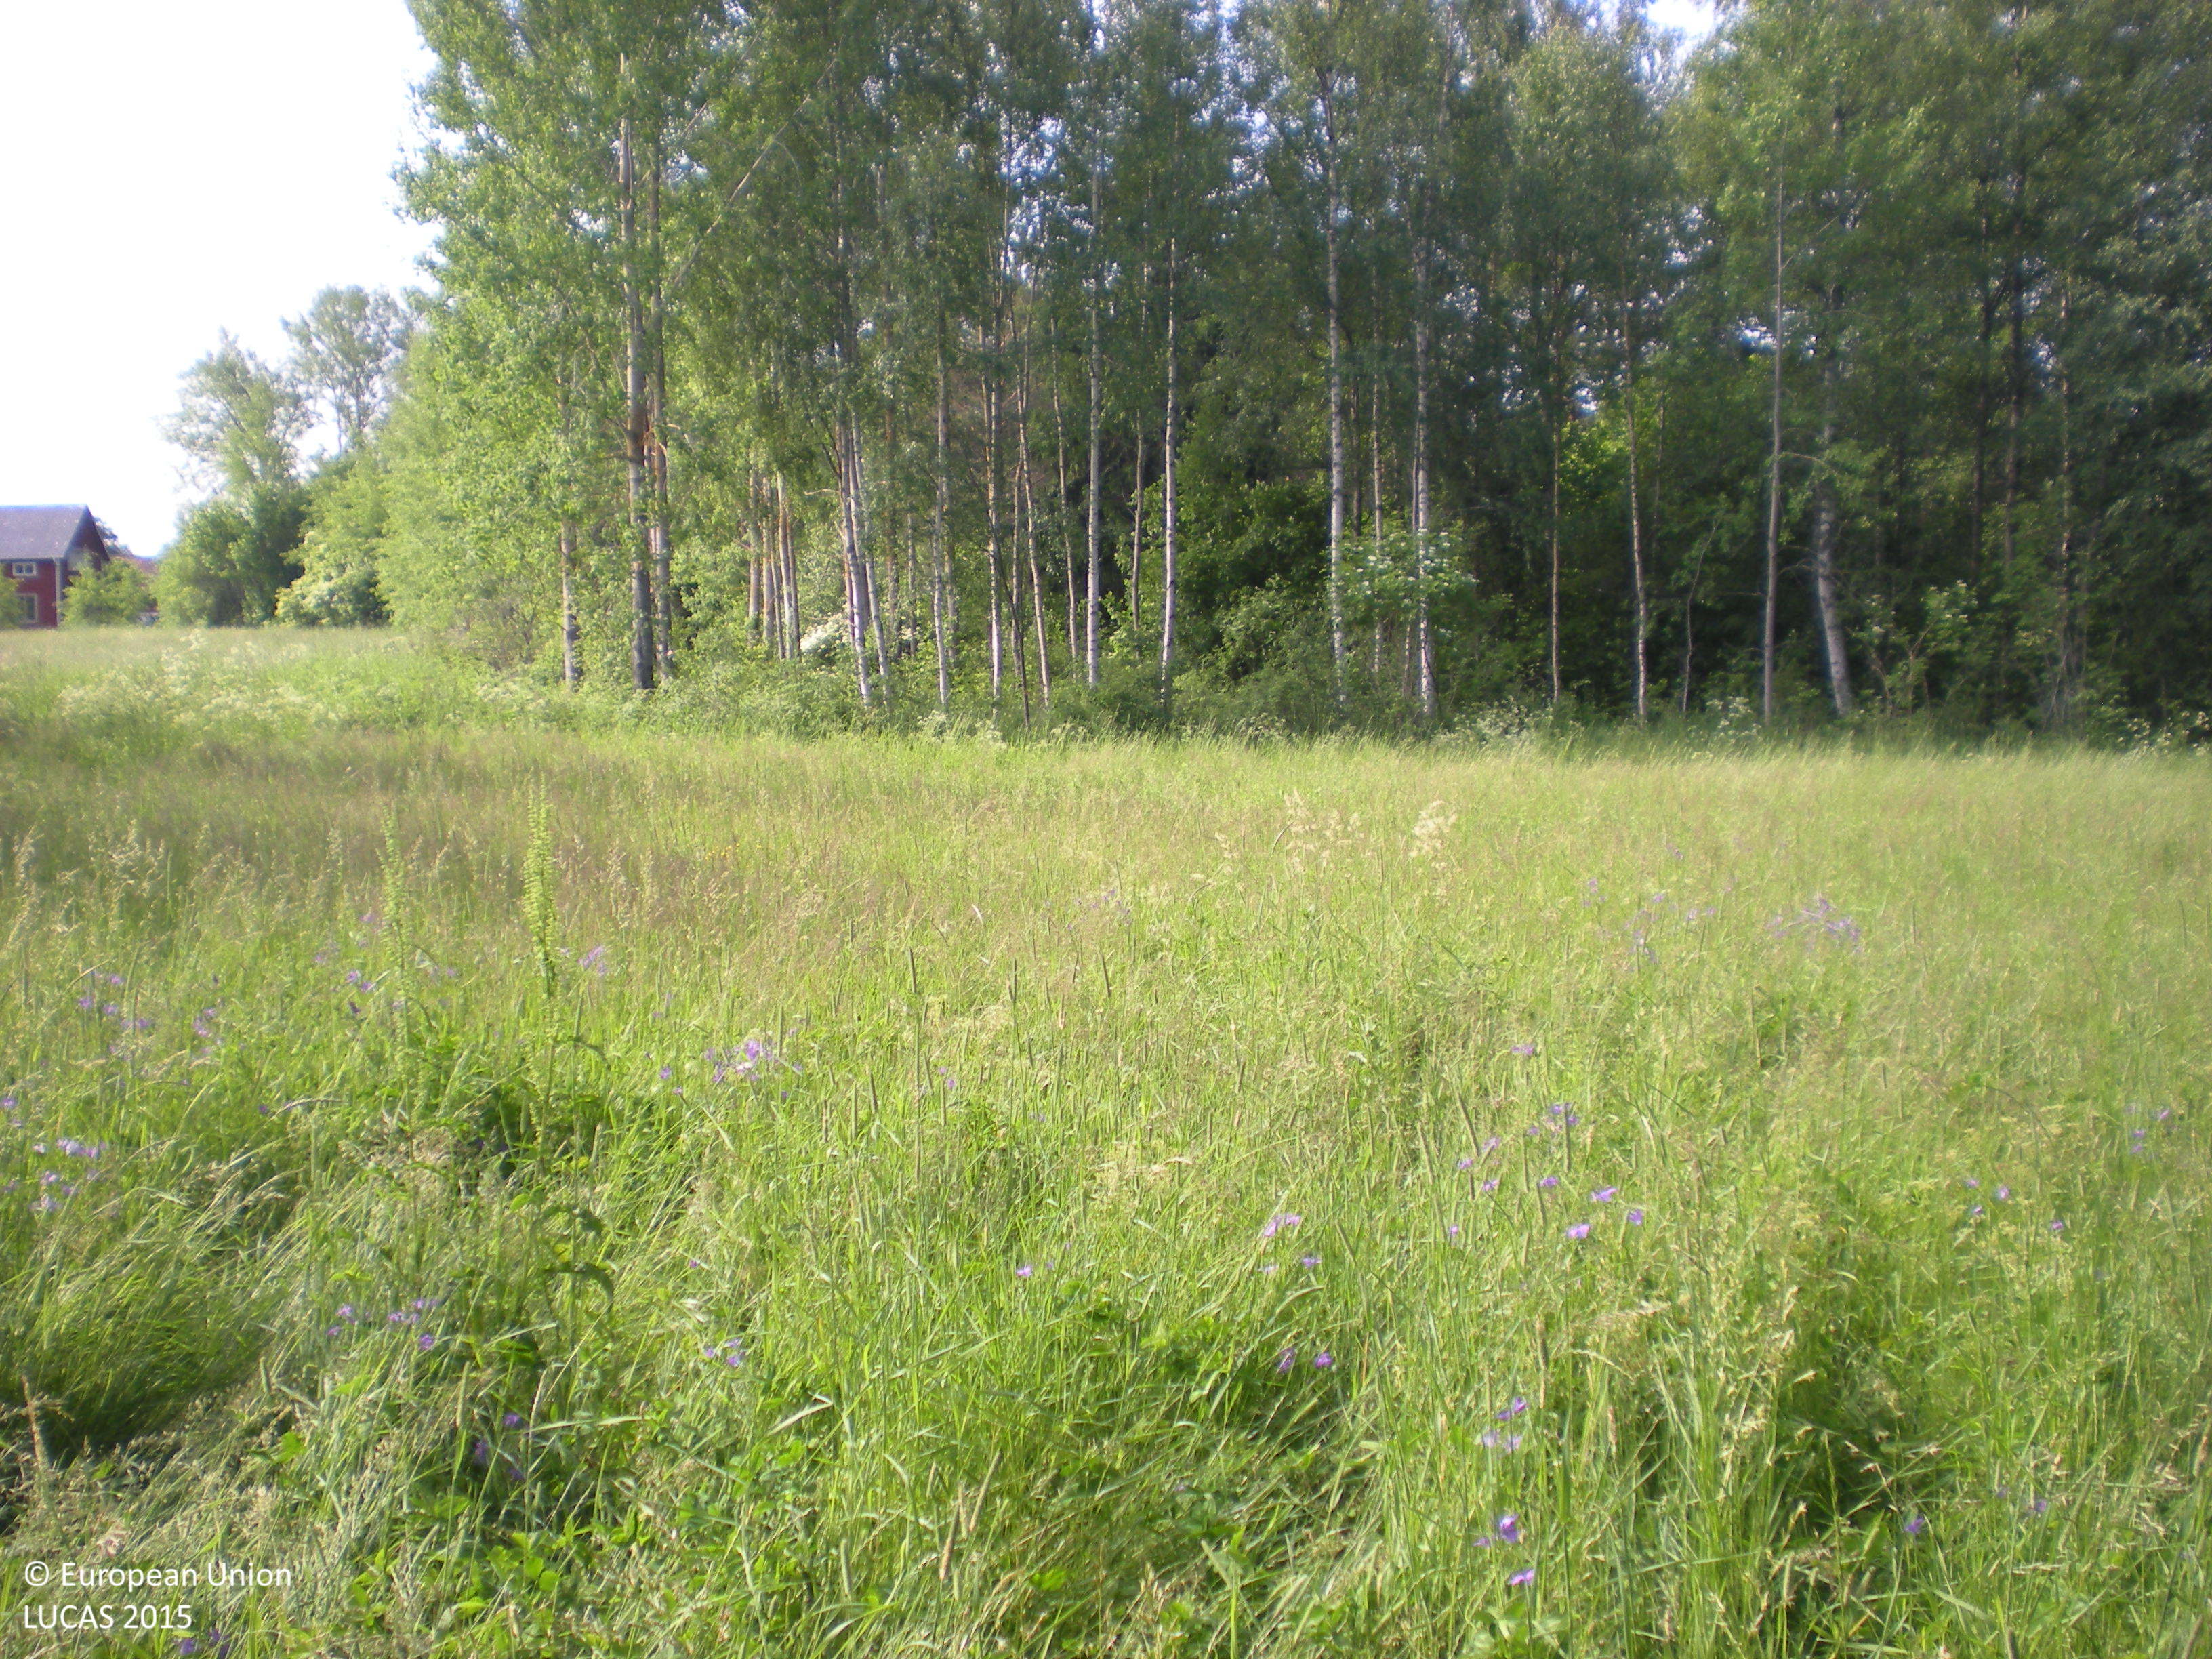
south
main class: Grassland
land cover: Grassland without tree/shrub cover
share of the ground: > 75 %
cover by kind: herbaceous plants 100 %
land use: Agriculture (excluding fallow land and kitchen gardens)
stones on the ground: 10 - 25 %
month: July
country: SE
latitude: 60.5015
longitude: 17.9121
